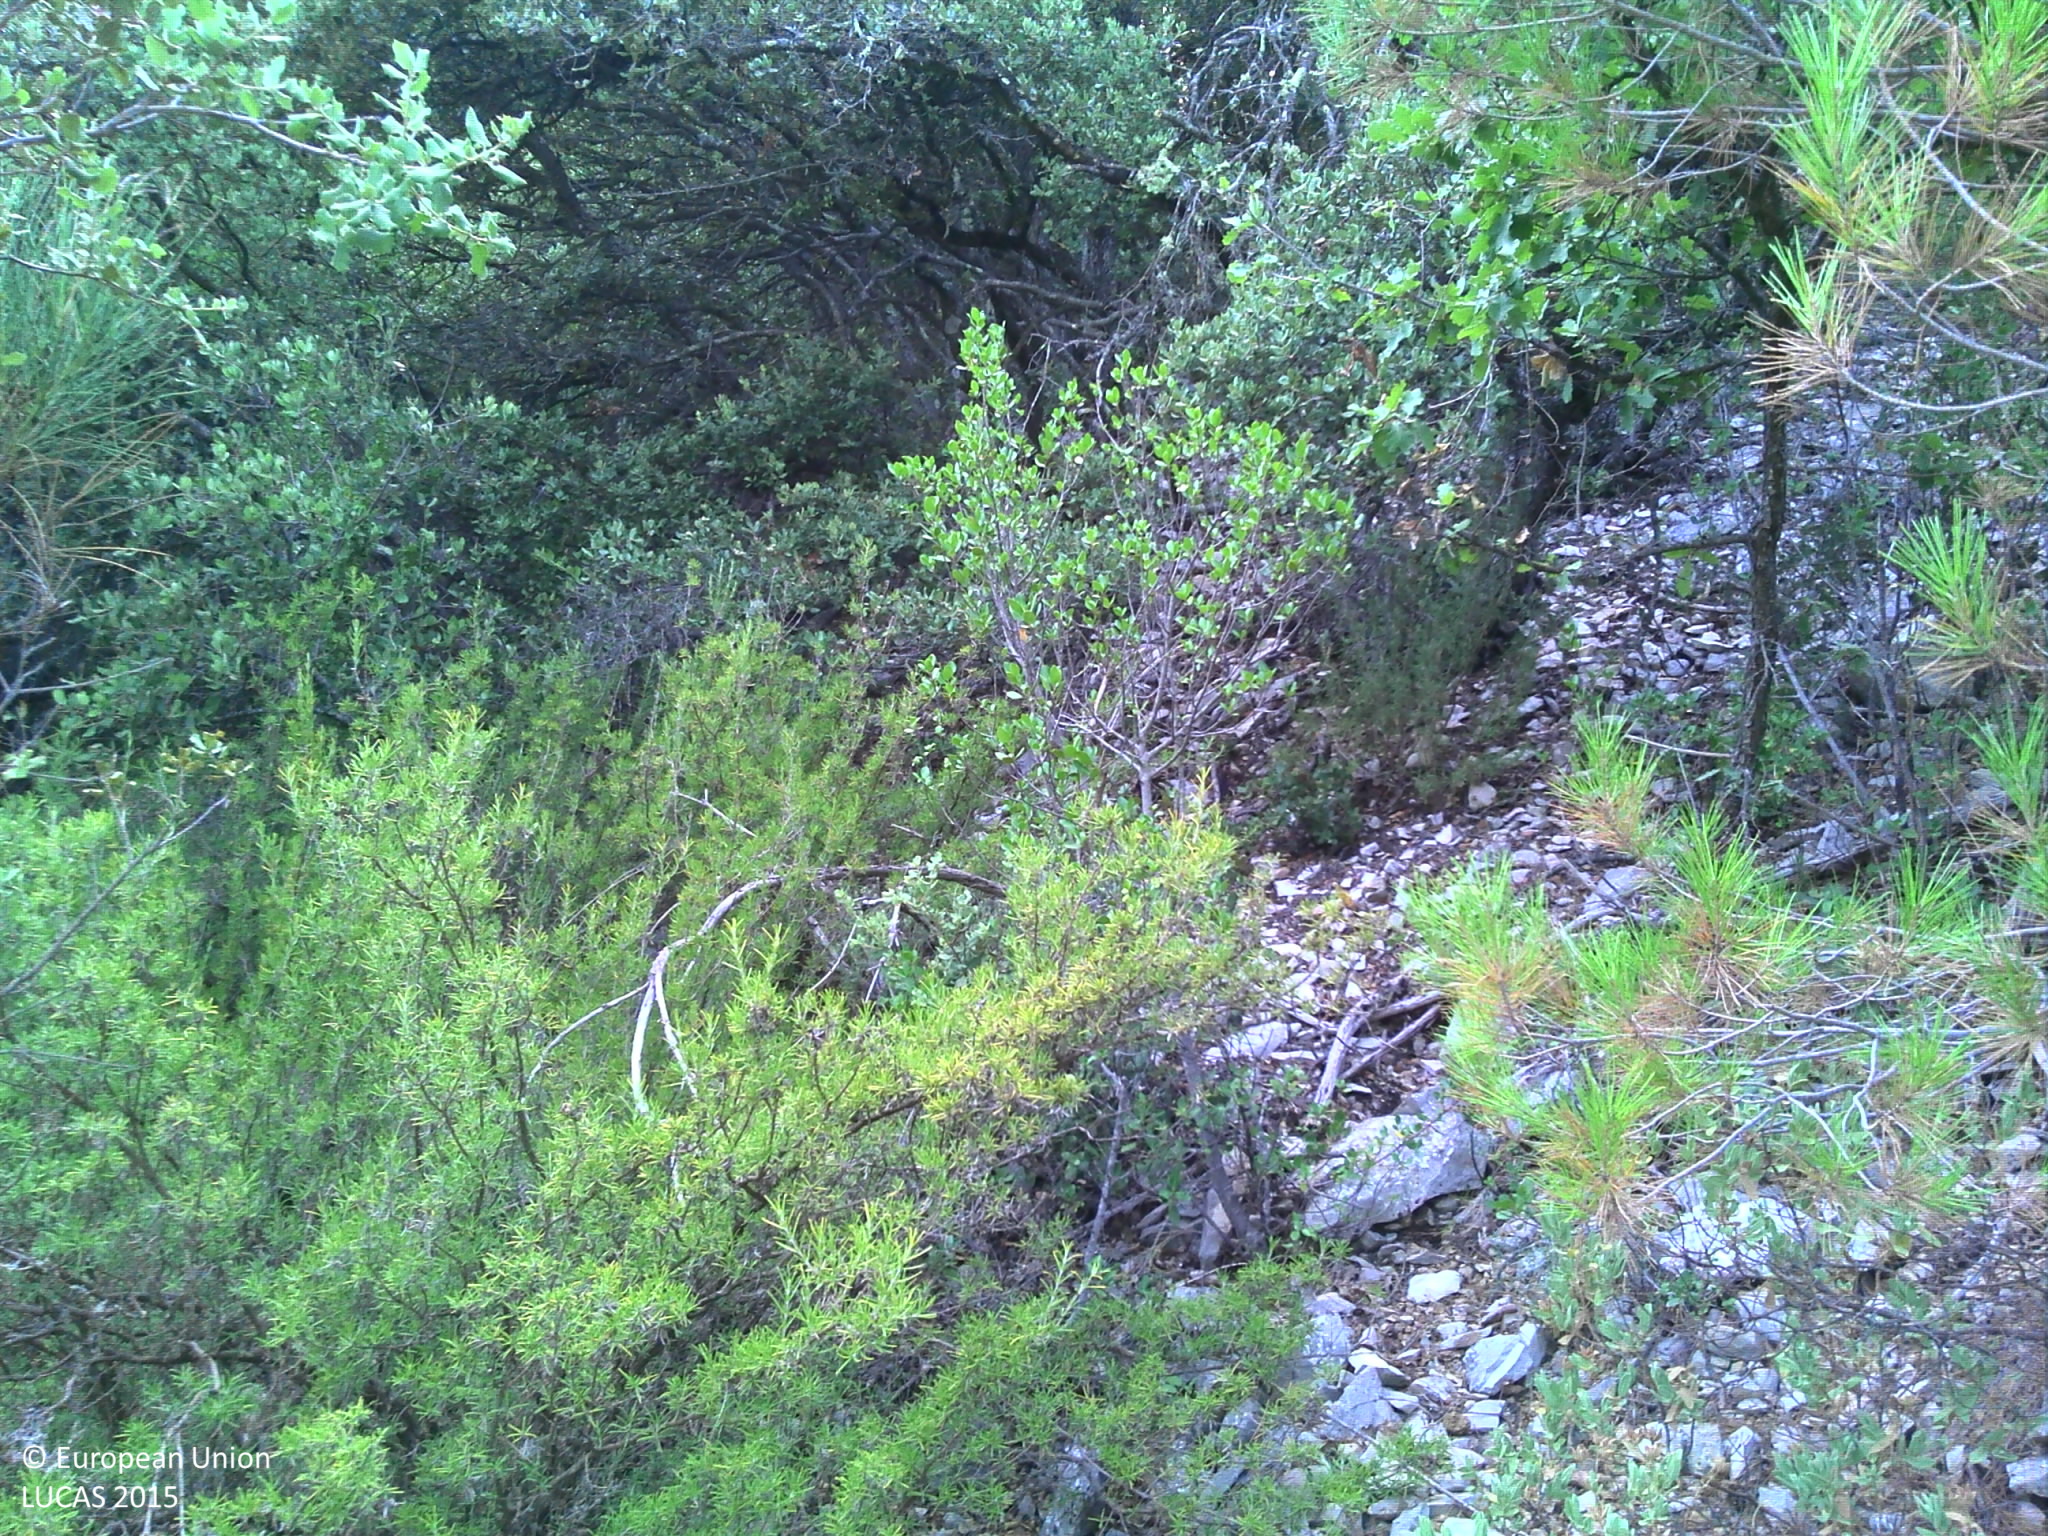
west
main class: Woodland
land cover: Broadleaved woodland
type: broadleaved evergreen forest
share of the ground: > 75 %
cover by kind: broadleaved forest trees 50 %, shrubs 25 %, unconsolidated bare surface 15 %, herbaceous plants 10 %
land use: Semi-natural and natural areas not in use
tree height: > 5 m
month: July
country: FR
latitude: 43.7744
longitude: 5.3004
